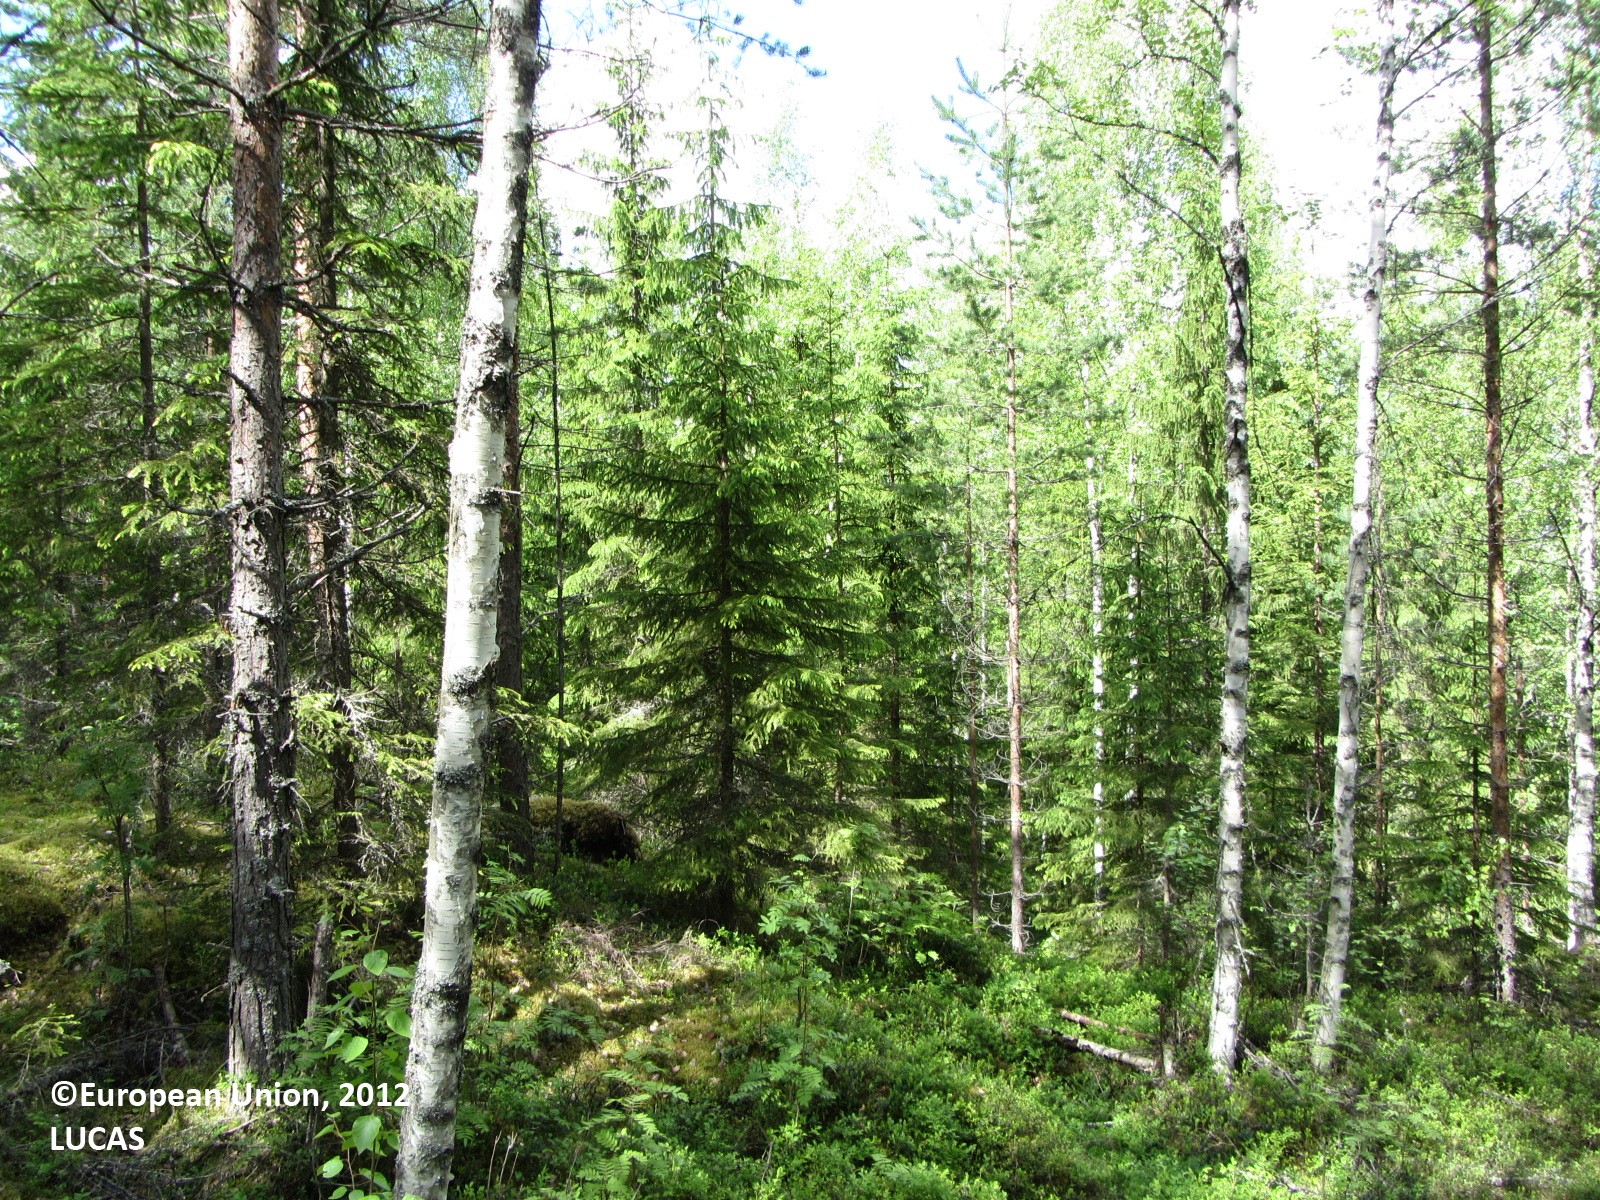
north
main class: Woodland
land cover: Pine dominated mixed woodland
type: boreal forest
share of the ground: > 75 %
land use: Forestry
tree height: > 5 m
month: June
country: FI
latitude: 61.9552
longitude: 24.9176
